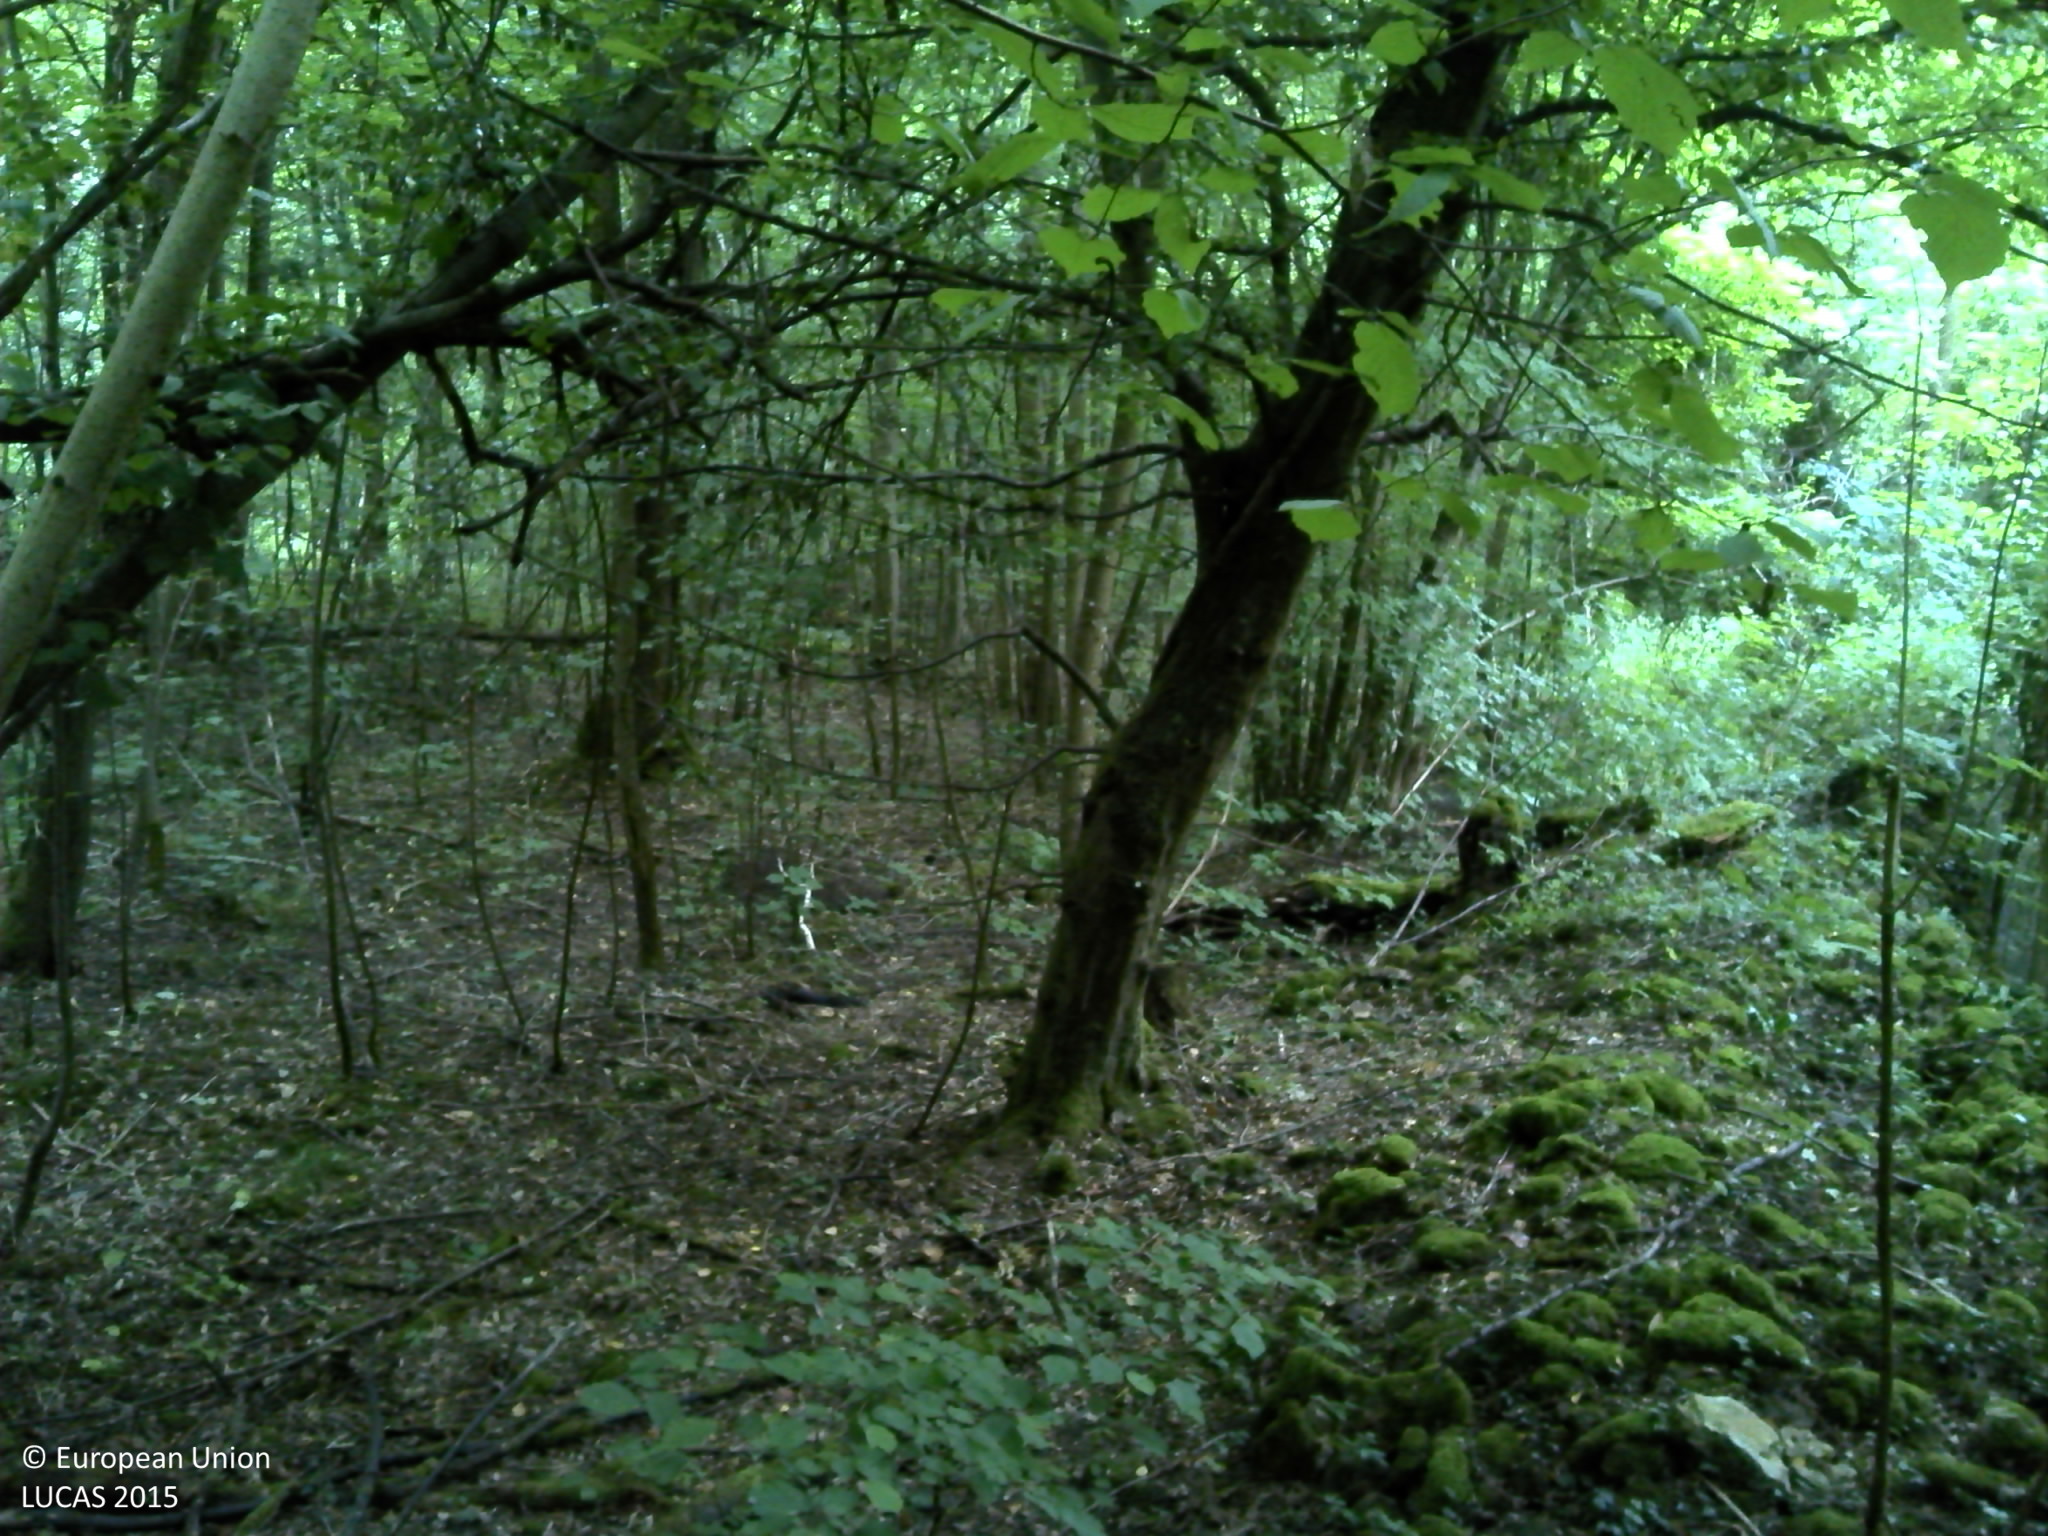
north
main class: Woodland
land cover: Broadleaved woodland
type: mesophytic deciduous forest
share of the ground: > 75 %
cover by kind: broadleaved forest trees 95 %, herbaceous plants 5 %
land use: Forestry
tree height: > 5 m
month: July
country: FR
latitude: 48.7524
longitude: 1.8377
